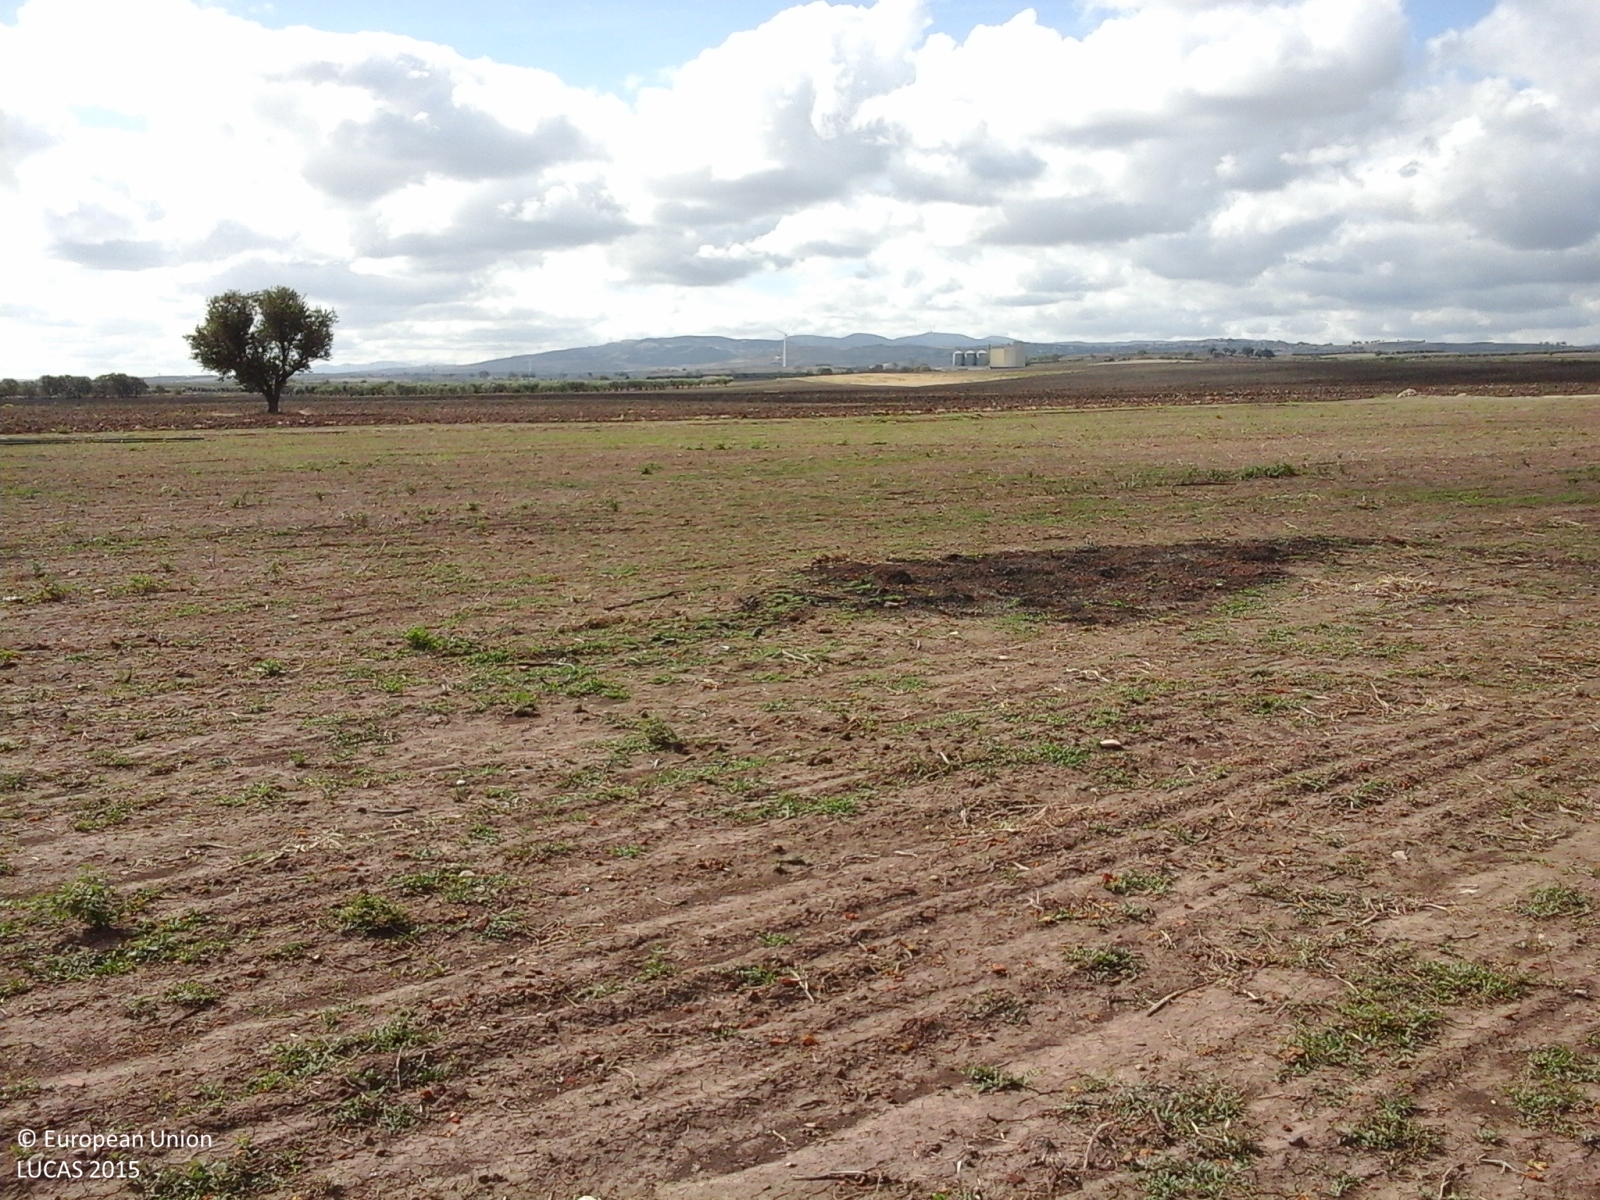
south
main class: Cropland
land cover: Tomatoes
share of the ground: < 10 %
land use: Agriculture (excluding fallow land and kitchen gardens)
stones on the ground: < 10 %
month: September
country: IT
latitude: 41.6730
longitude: 15.1363
